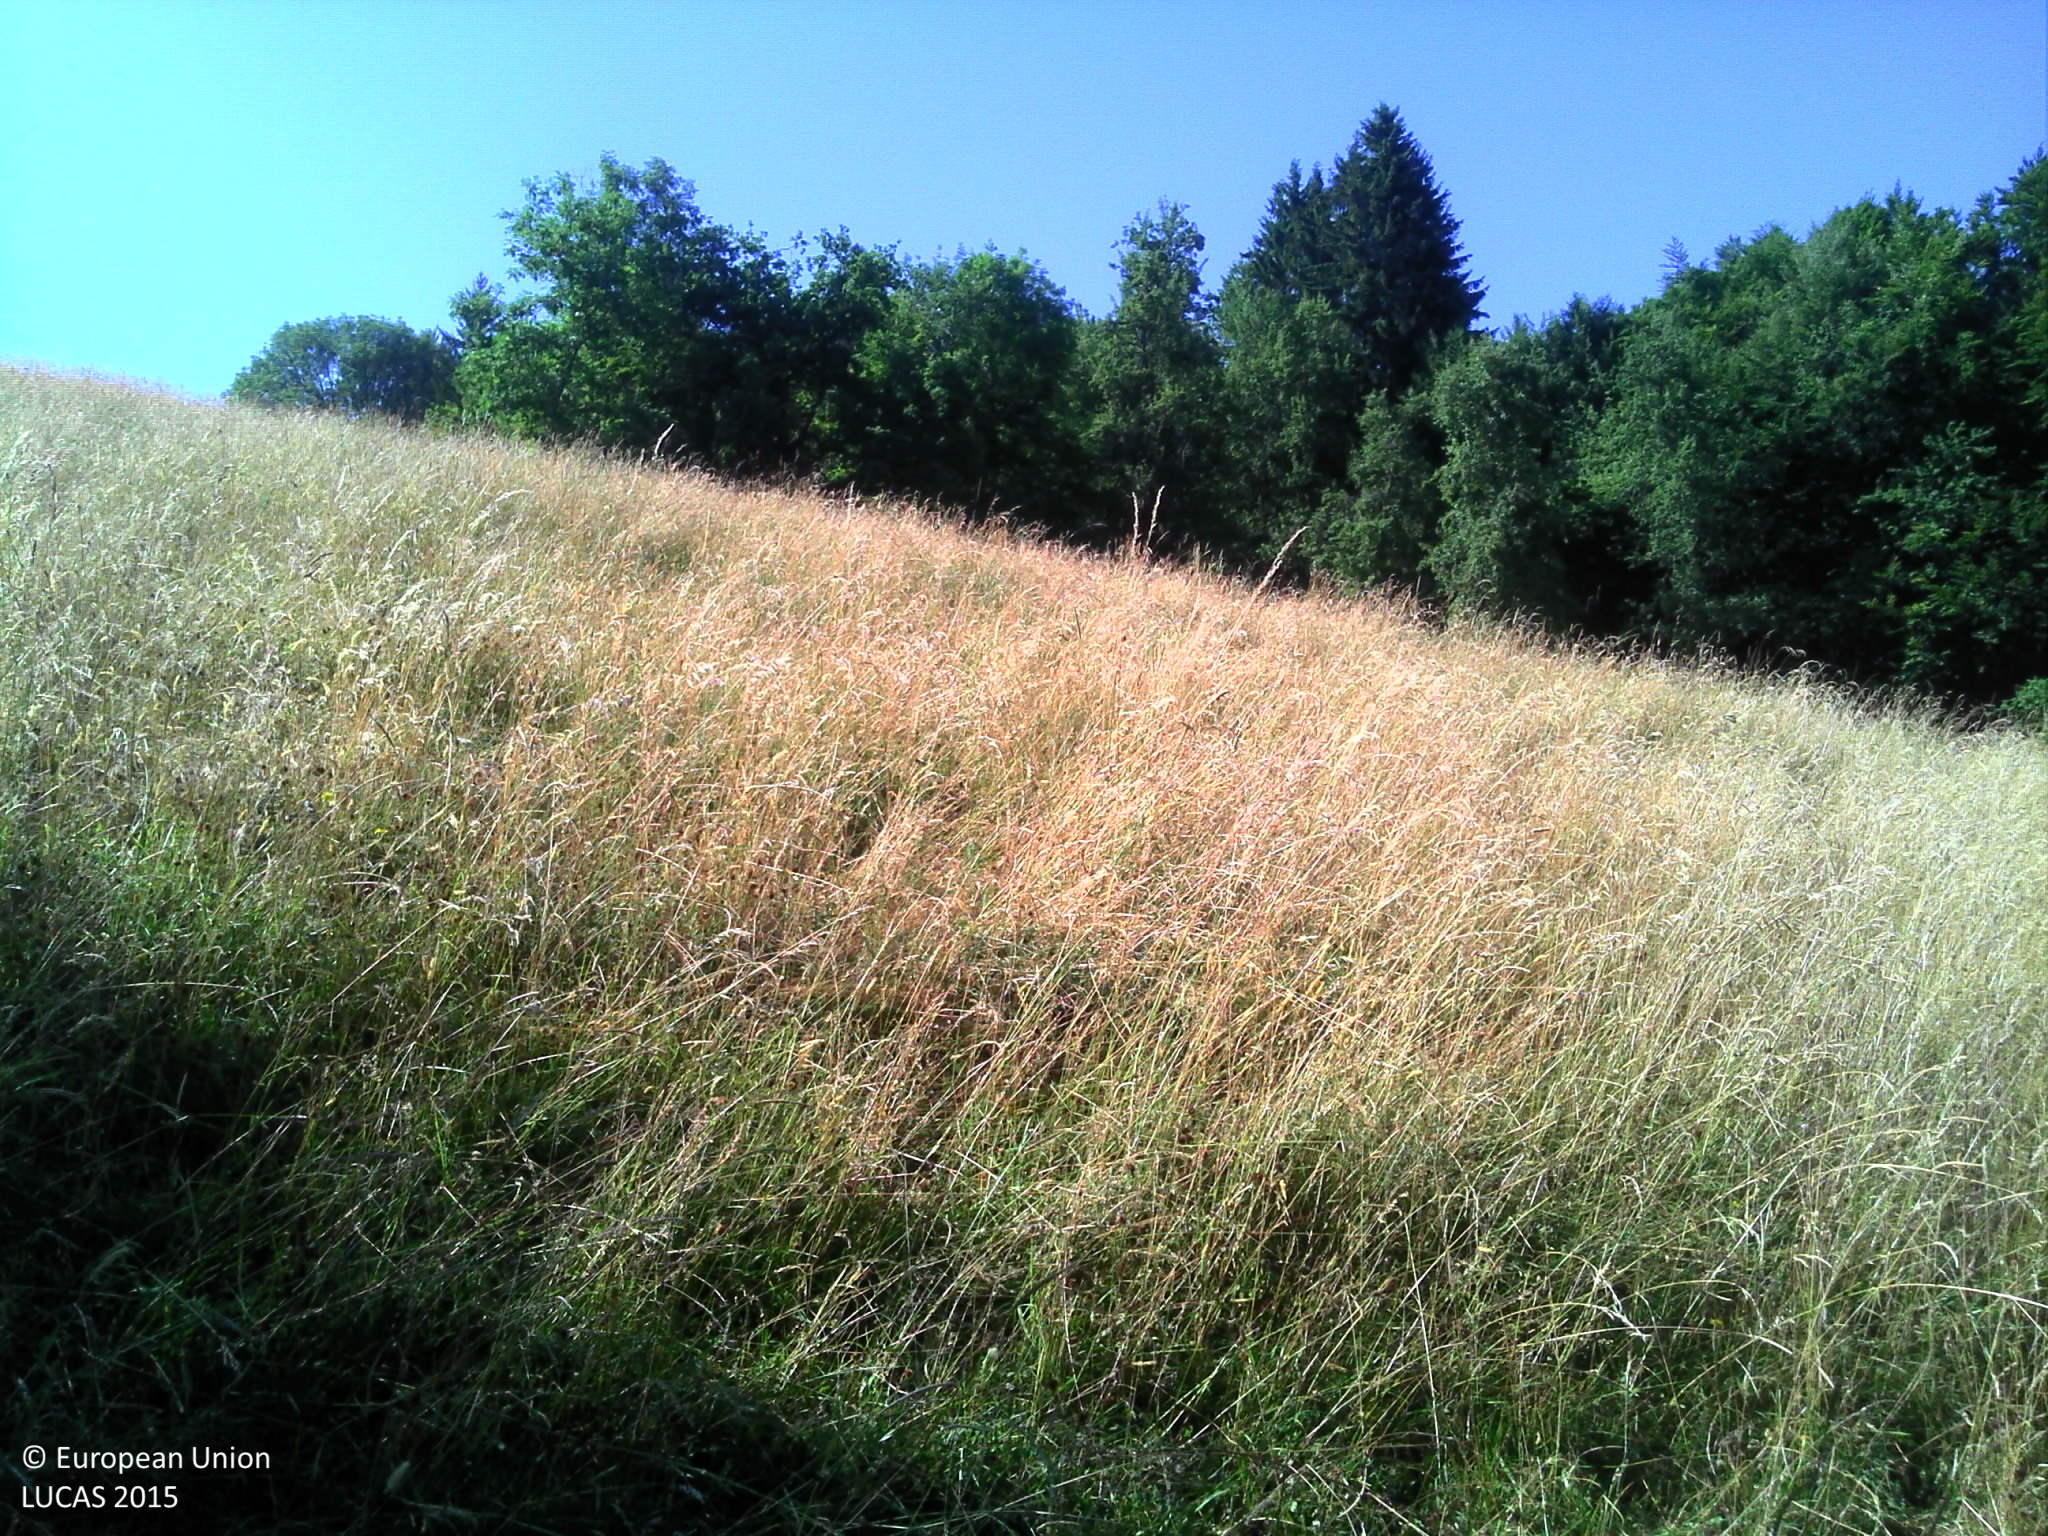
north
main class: Grassland
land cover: Grassland without tree/shrub cover
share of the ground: > 75 %
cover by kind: herbaceous plants 100 %
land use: Agriculture (excluding fallow land and kitchen gardens)
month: July
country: FR
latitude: 46.2378
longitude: 6.4372
